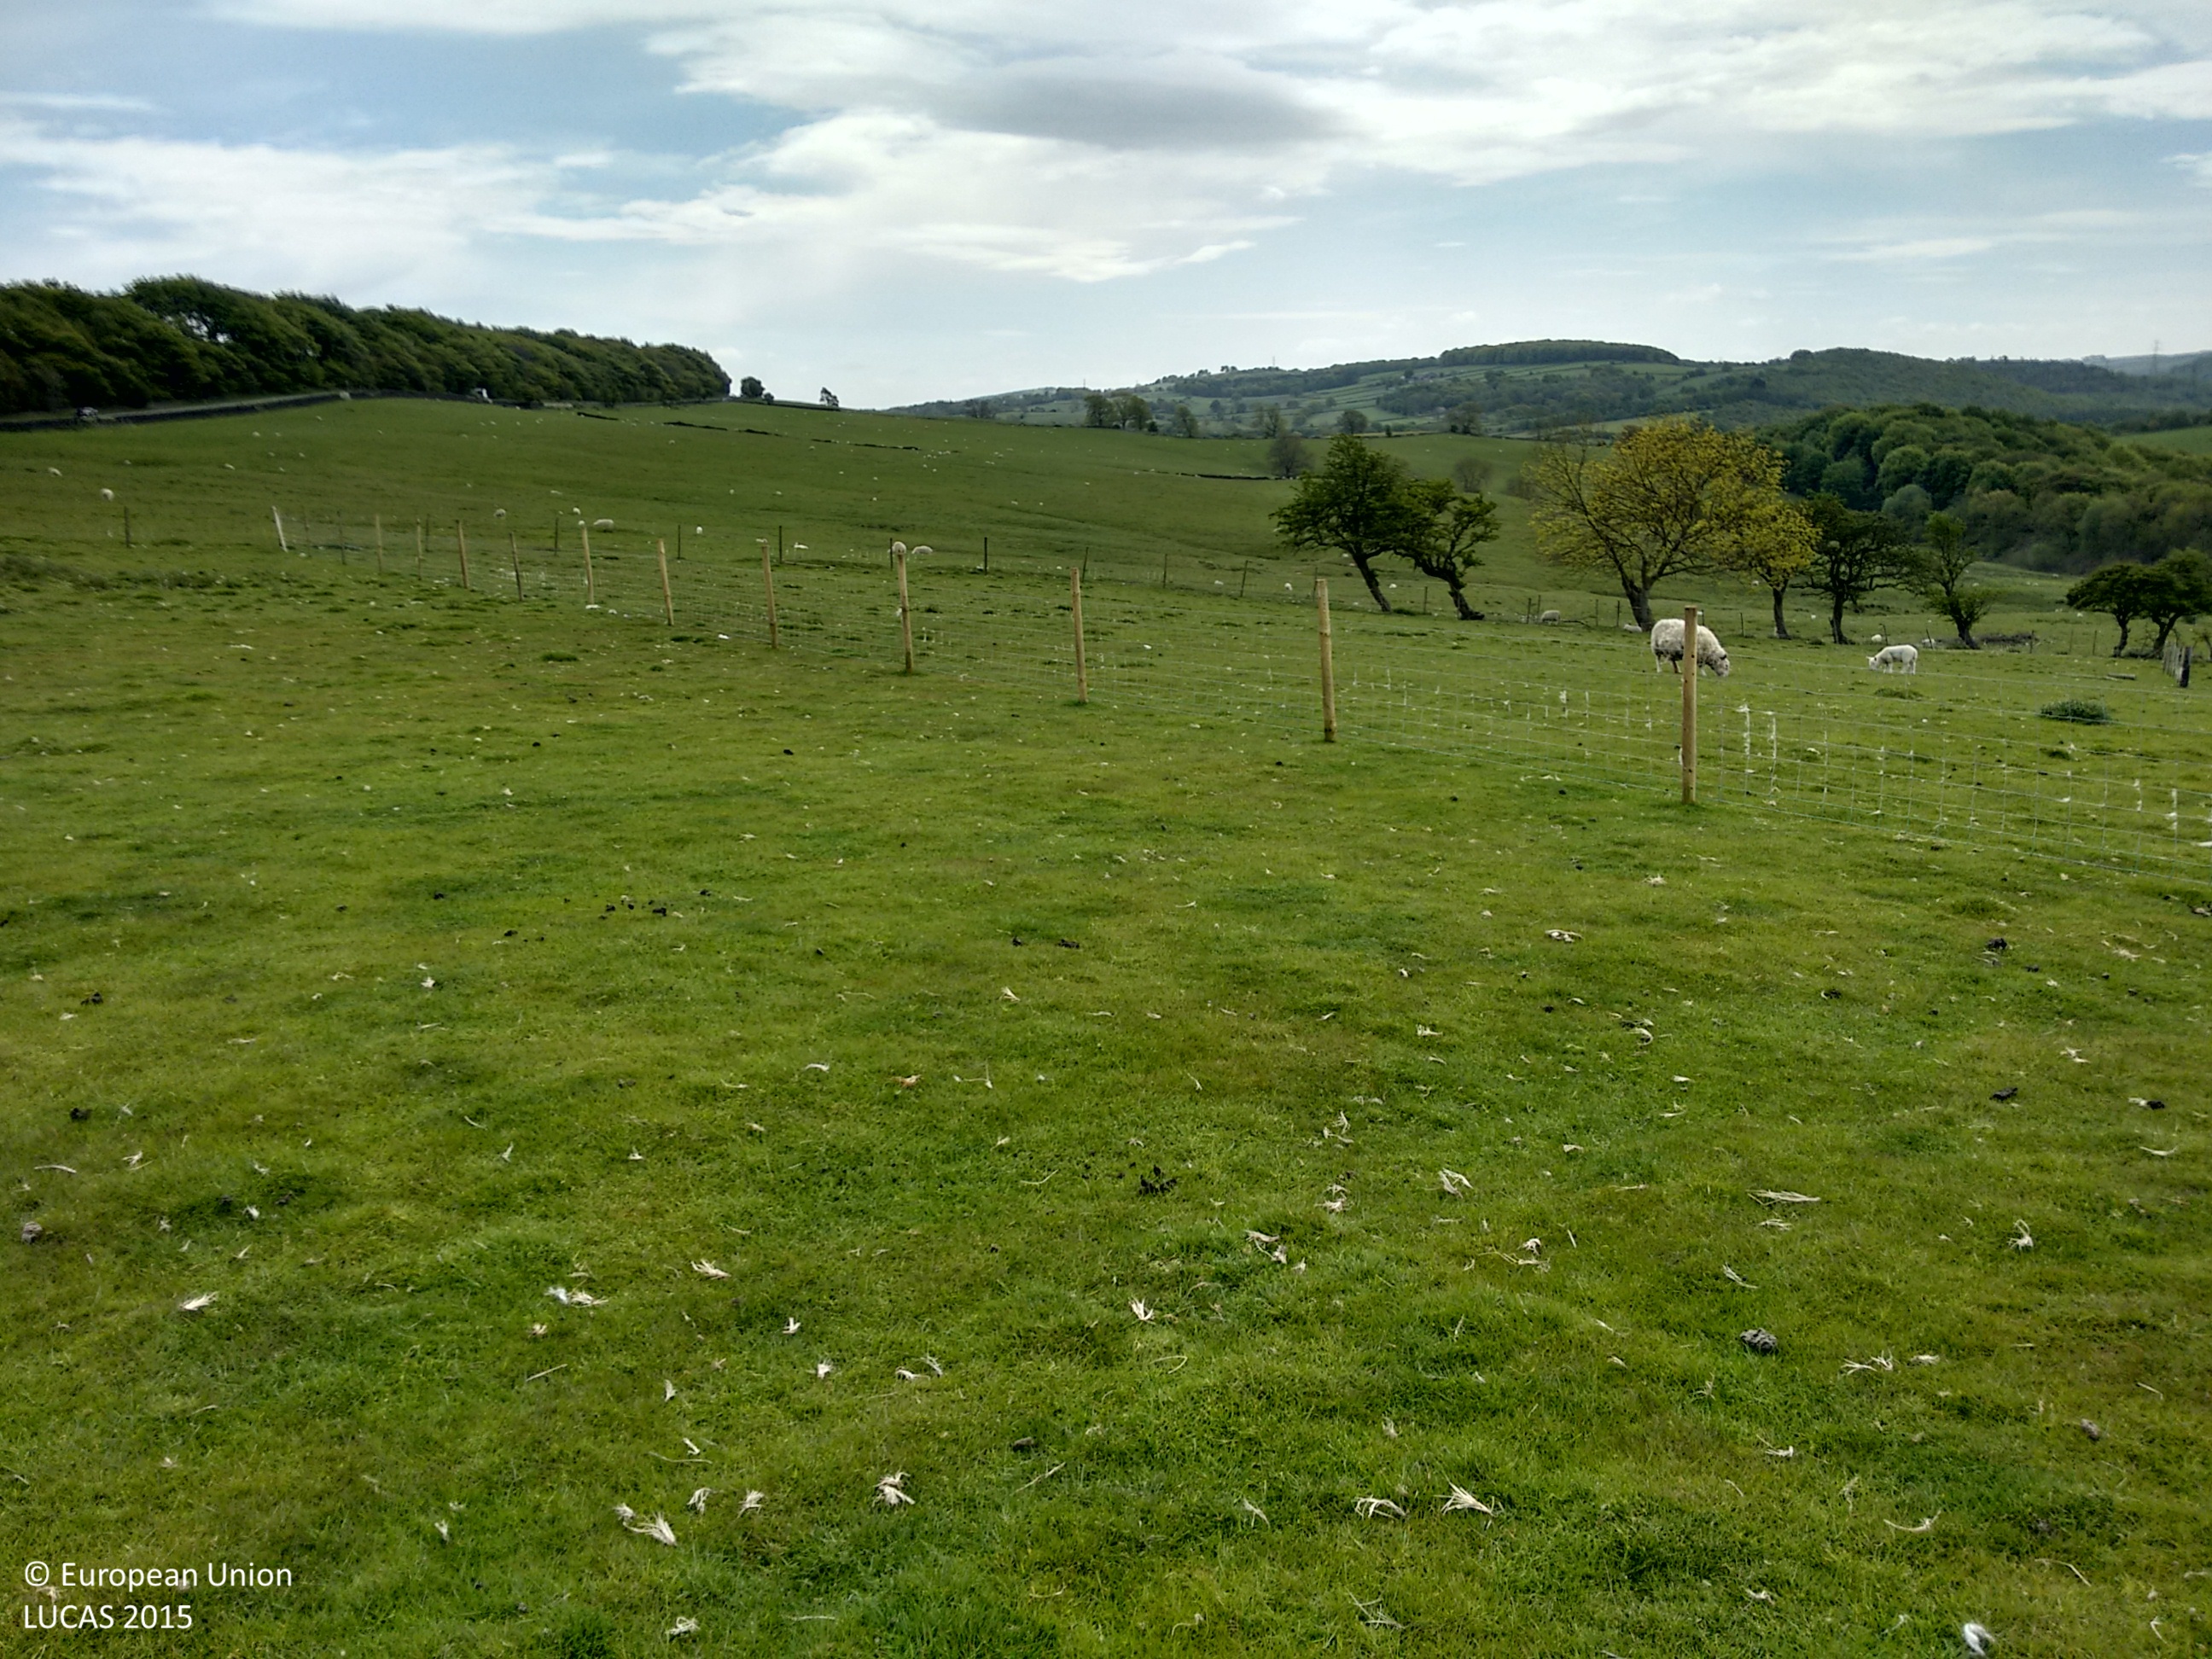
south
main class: Grassland
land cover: Grassland without tree/shrub cover
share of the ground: > 75 %
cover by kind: herbaceous plants 100 %
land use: Agriculture (excluding fallow land and kitchen gardens)
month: May
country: GB
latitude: 53.5009
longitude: -1.5537
